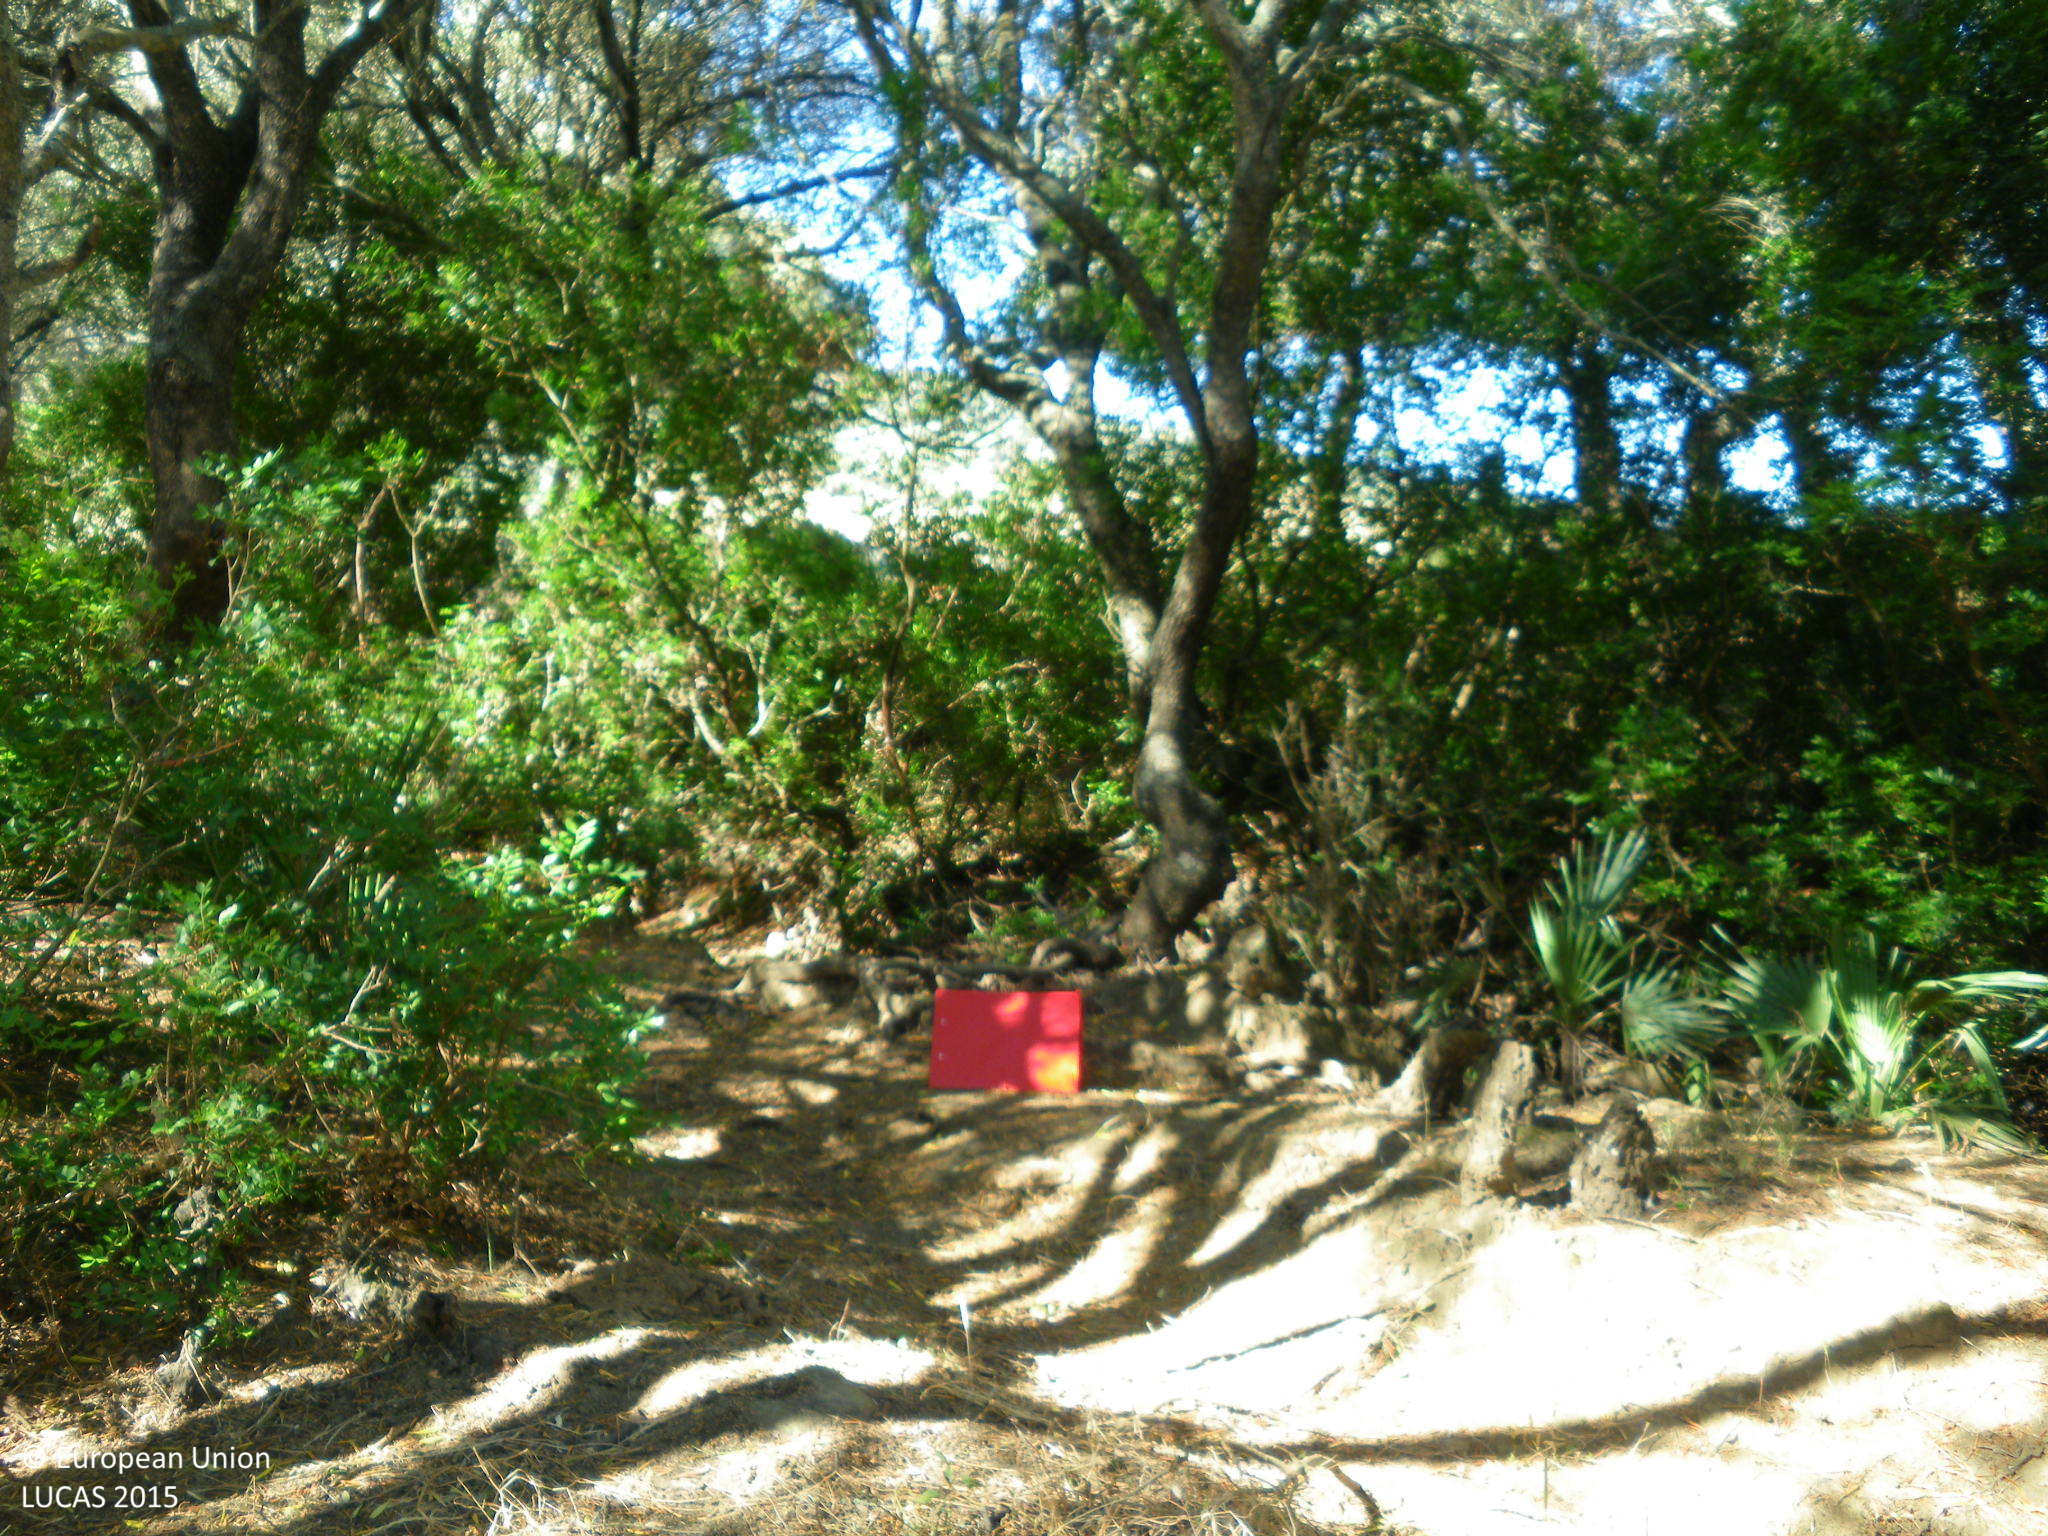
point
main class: Woodland
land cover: Broadleaved woodland
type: broadleaved evergreen forest
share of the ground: > 75 %
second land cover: Shrubland without tree cover
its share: 50 - 75 %
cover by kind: broadleaved forest trees 75 %, herbaceous plants 15 %, shrubs 5 %, unconsolidated bare surface 5 %
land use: Forestry
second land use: Agriculture (excluding fallow land and kitchen gardens)
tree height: > 5 m
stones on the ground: < 10 %
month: June
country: ES
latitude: 36.1252
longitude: -5.7844
